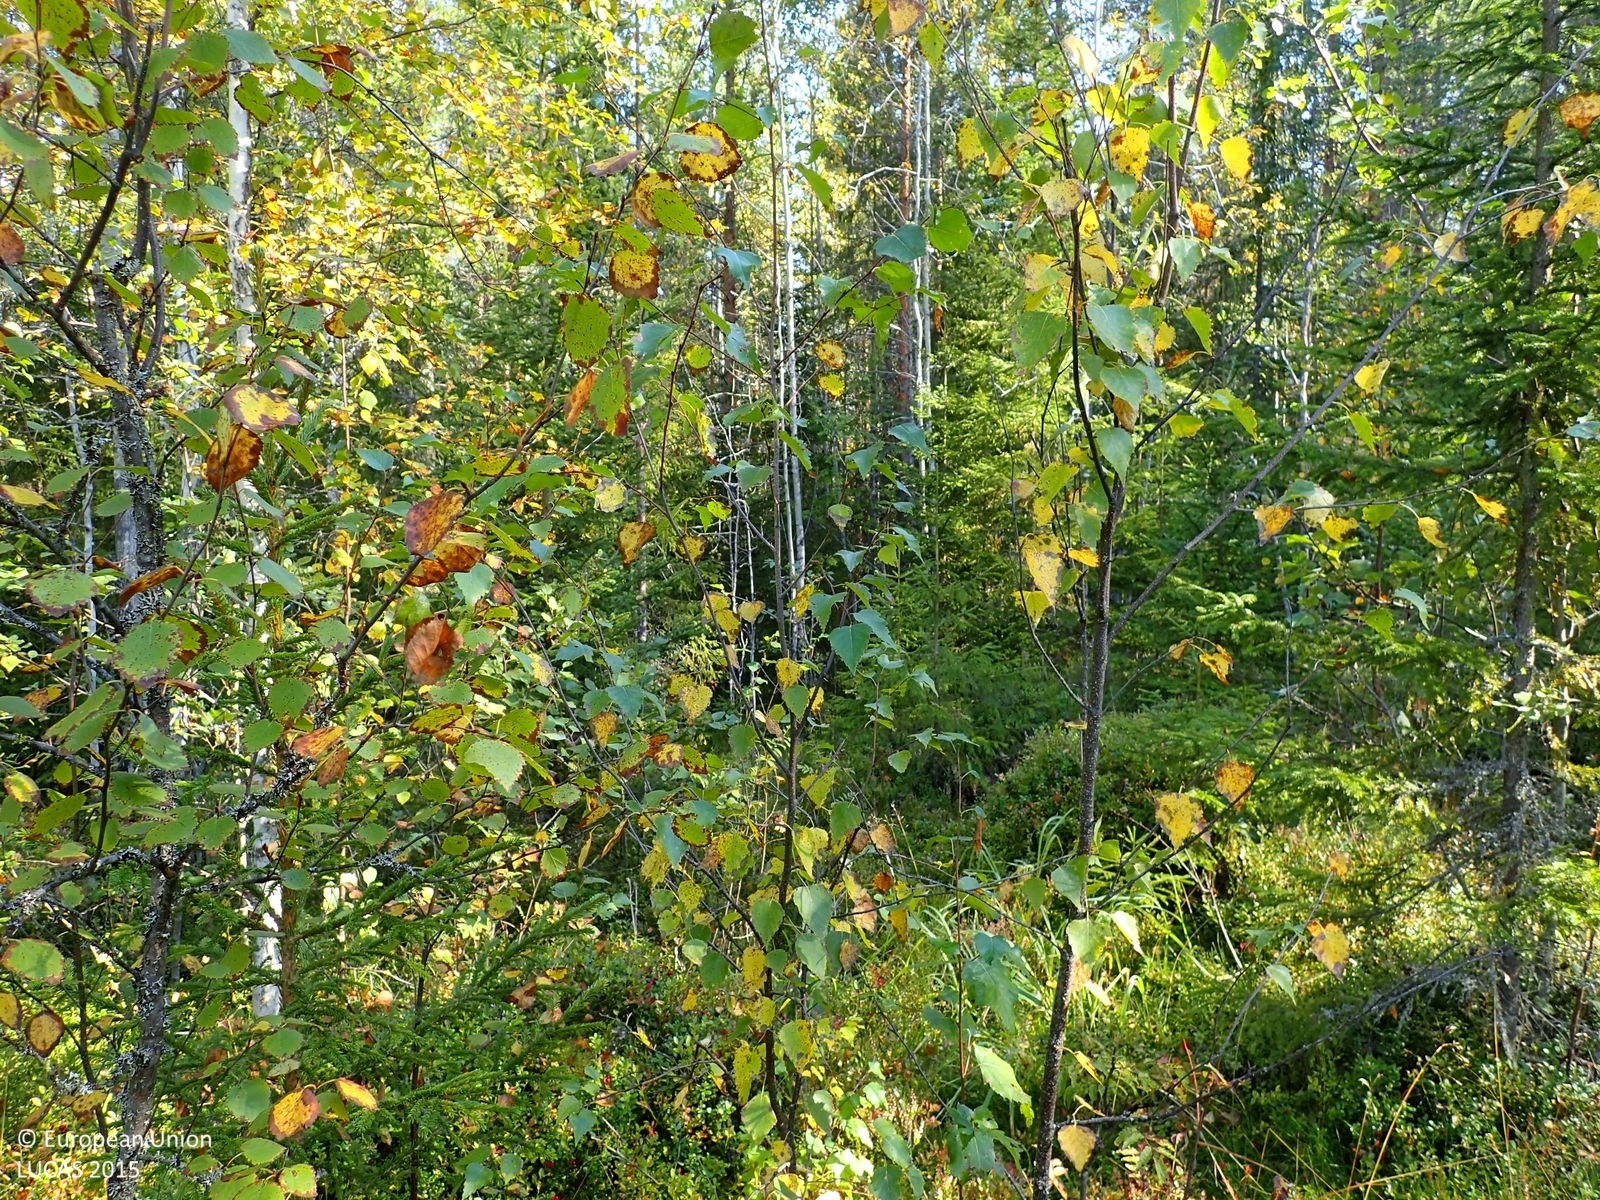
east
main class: Woodland
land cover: Spruce dominated mixed woodland
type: boreal forest
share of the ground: > 75 %
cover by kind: coniferous forest trees 40 %, broadleaved forest trees 35 %, shrubs 25 %
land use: Forestry
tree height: < 5 m
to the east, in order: Spruce dominated mixed woodland; Pine dominated mixed woodland; Tracks; Other mixed woodland
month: September
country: FI
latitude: 63.1920
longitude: 25.2633
